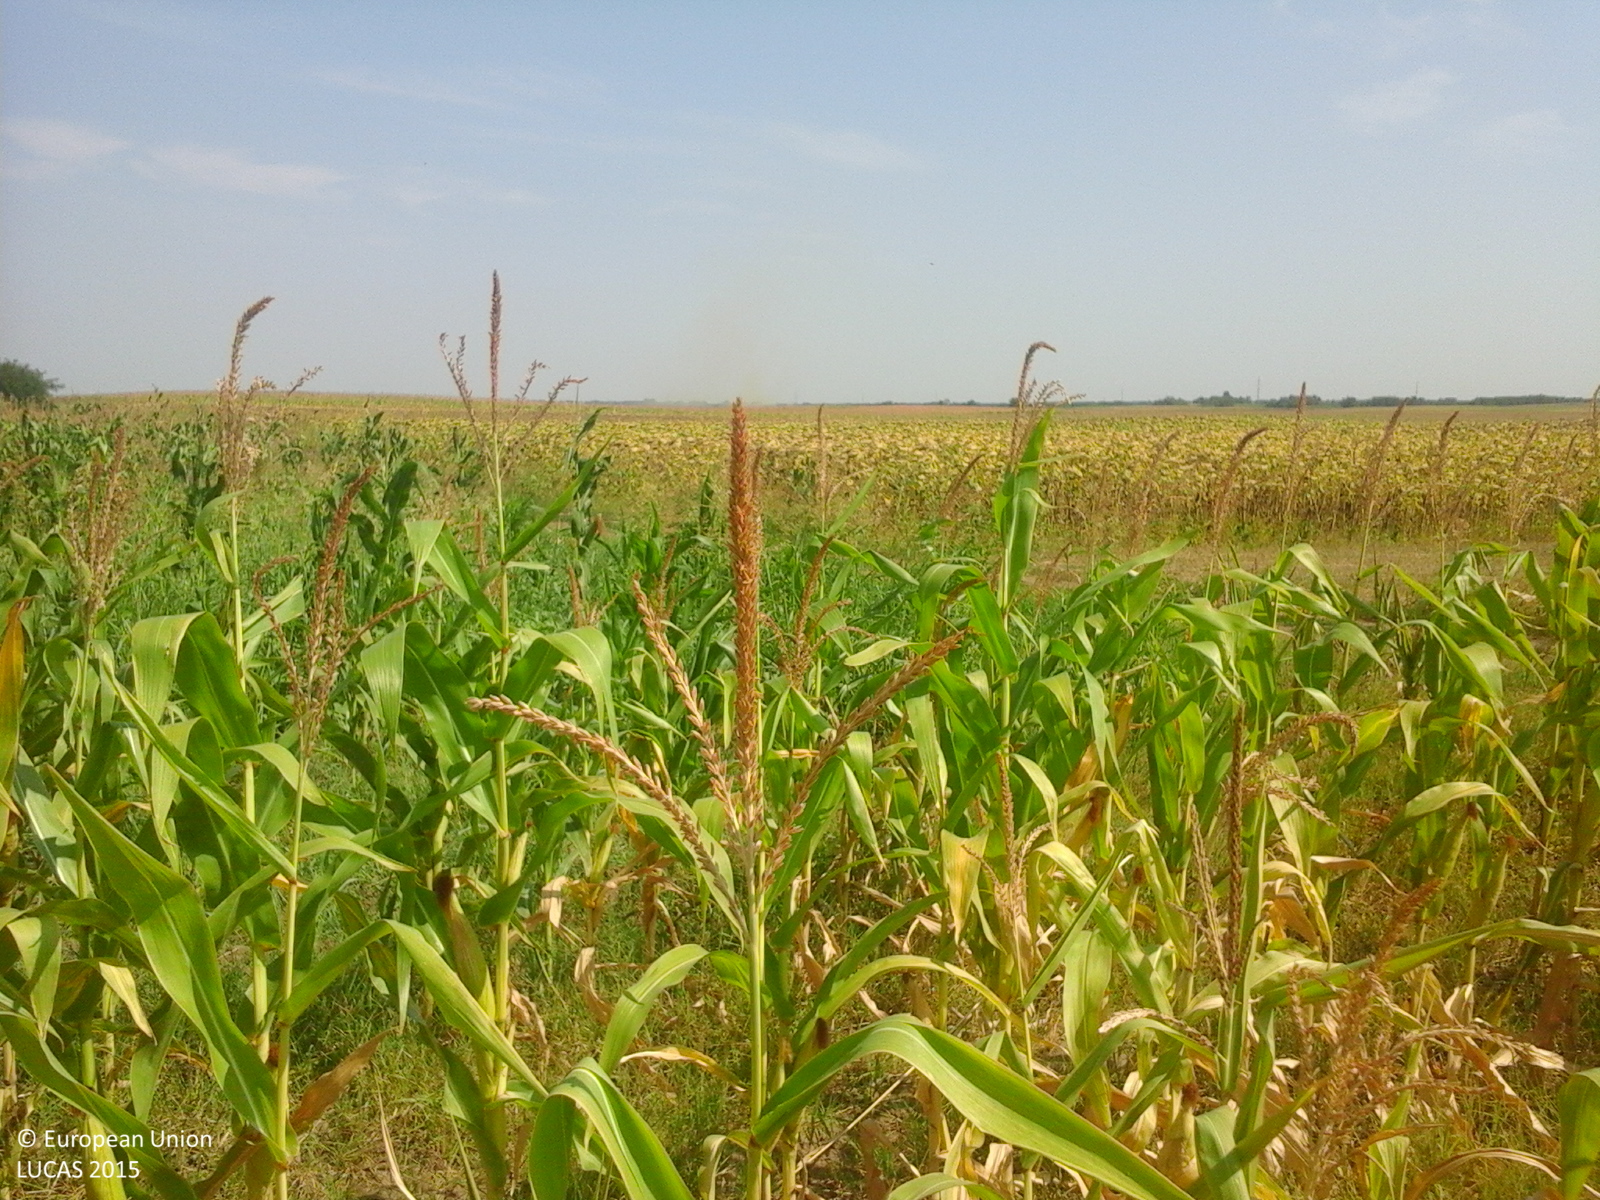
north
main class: Cropland
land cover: Maize
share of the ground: > 75 %
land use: Agriculture (excluding fallow land and kitchen gardens)
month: August
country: RO
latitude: 45.7420
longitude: 27.4942
